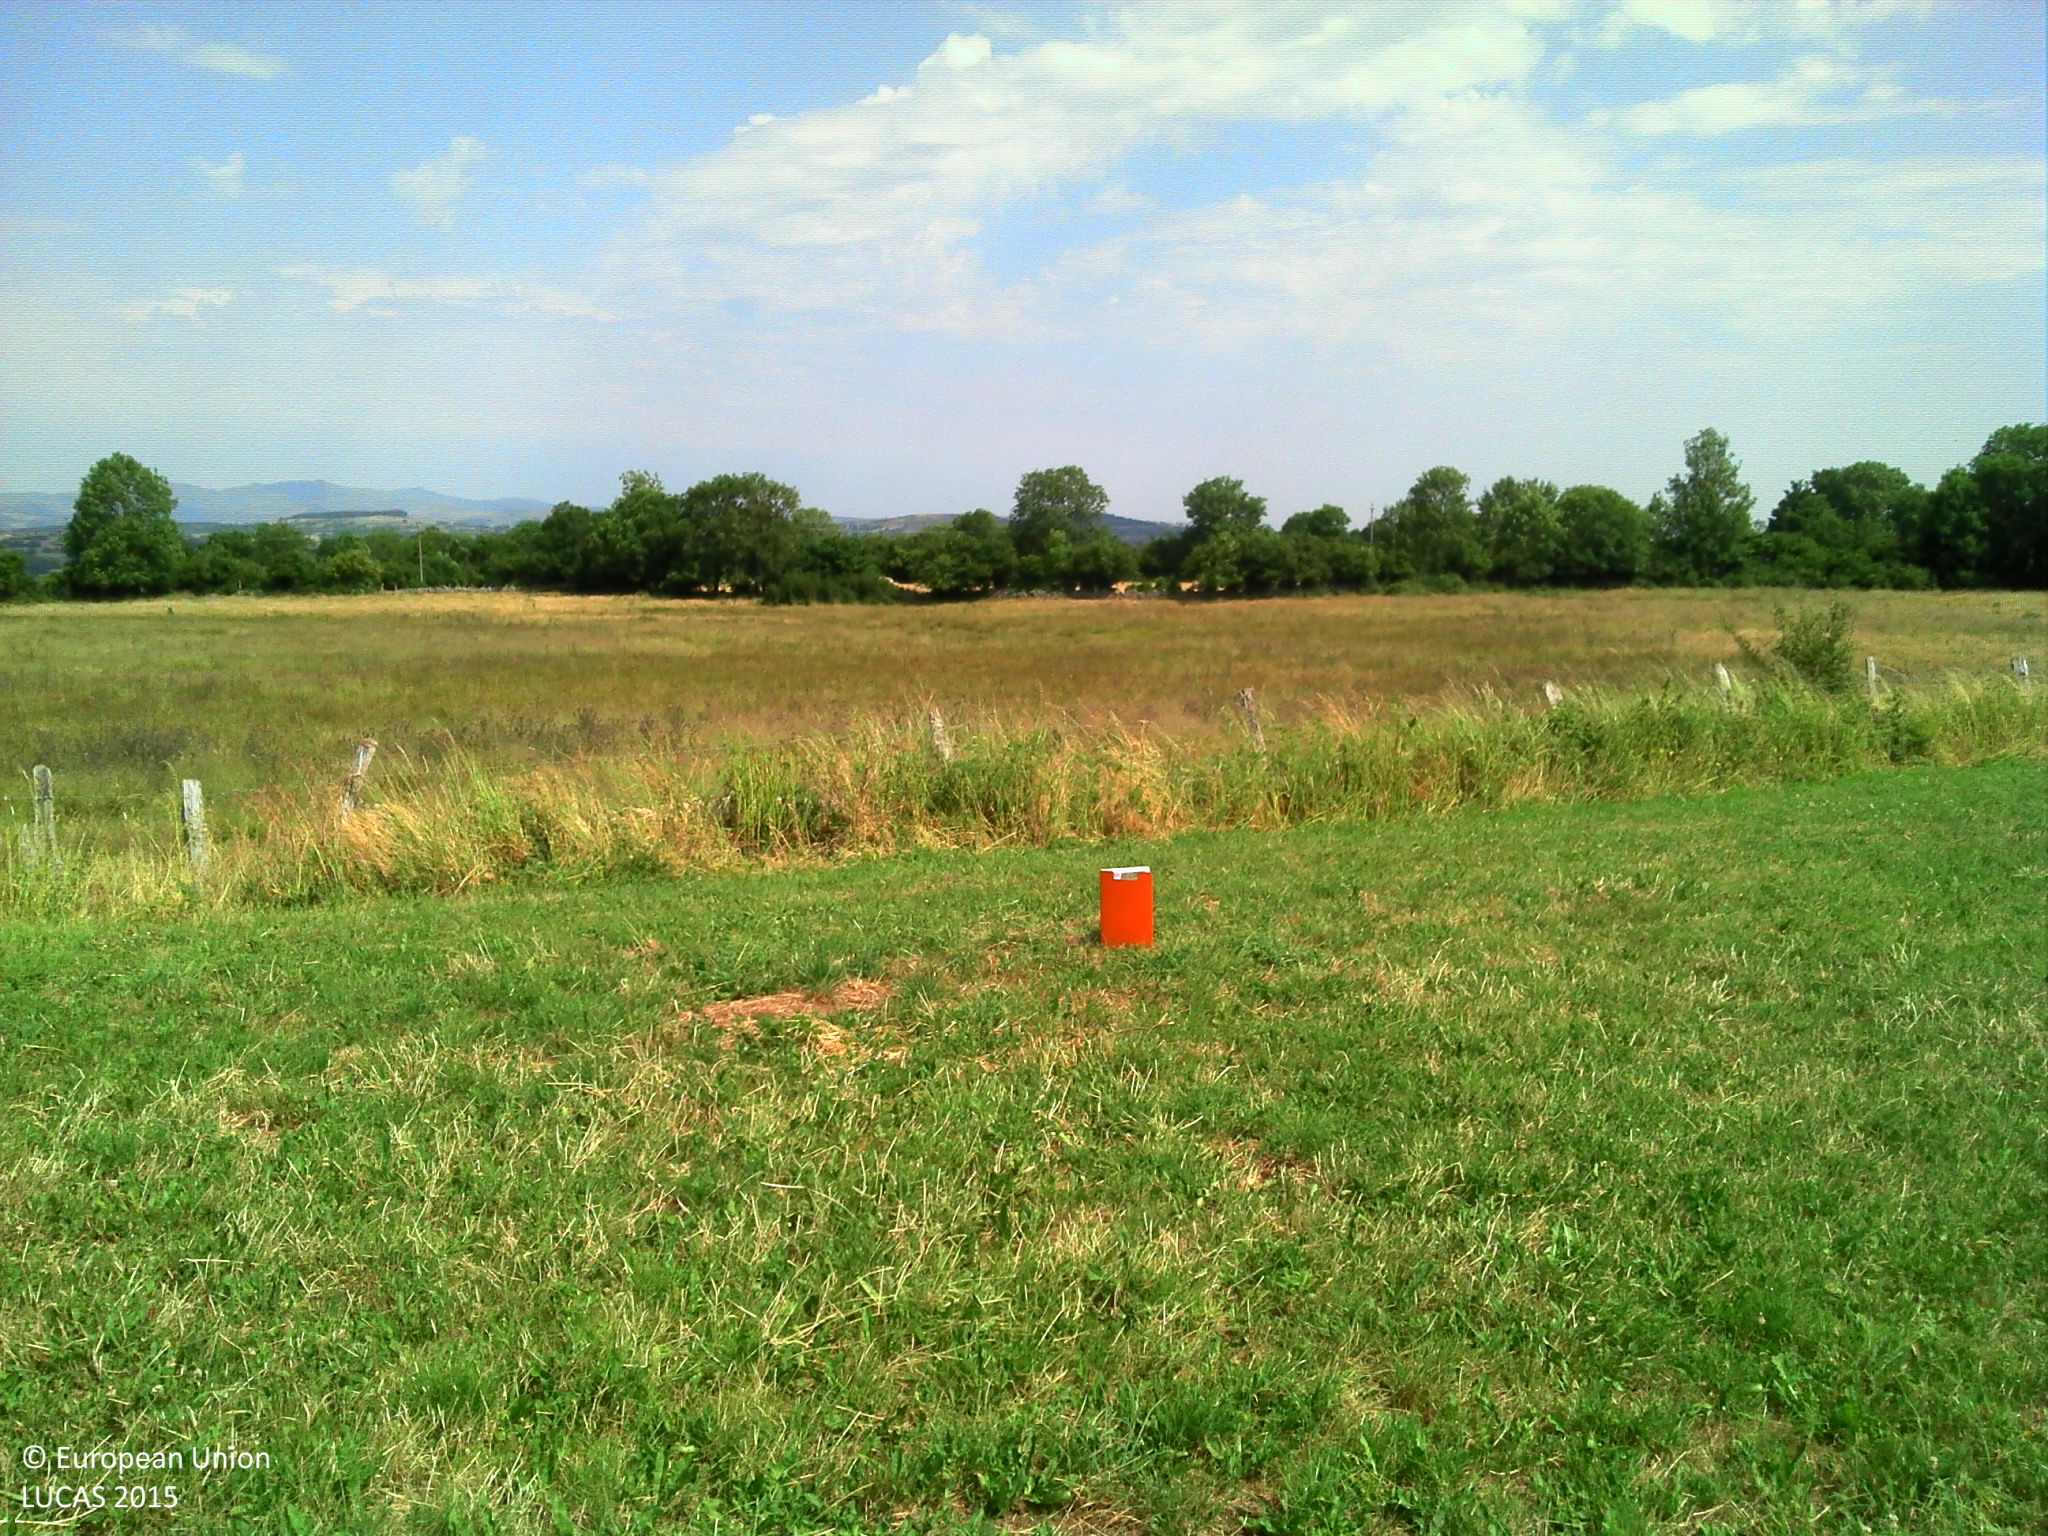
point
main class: Grassland
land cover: Grassland without tree/shrub cover
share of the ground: > 75 %
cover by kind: herbaceous plants 100 %
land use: Agriculture (excluding fallow land and kitchen gardens)
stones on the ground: < 10 %
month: July
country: FR
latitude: 44.8691
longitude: 2.9271
